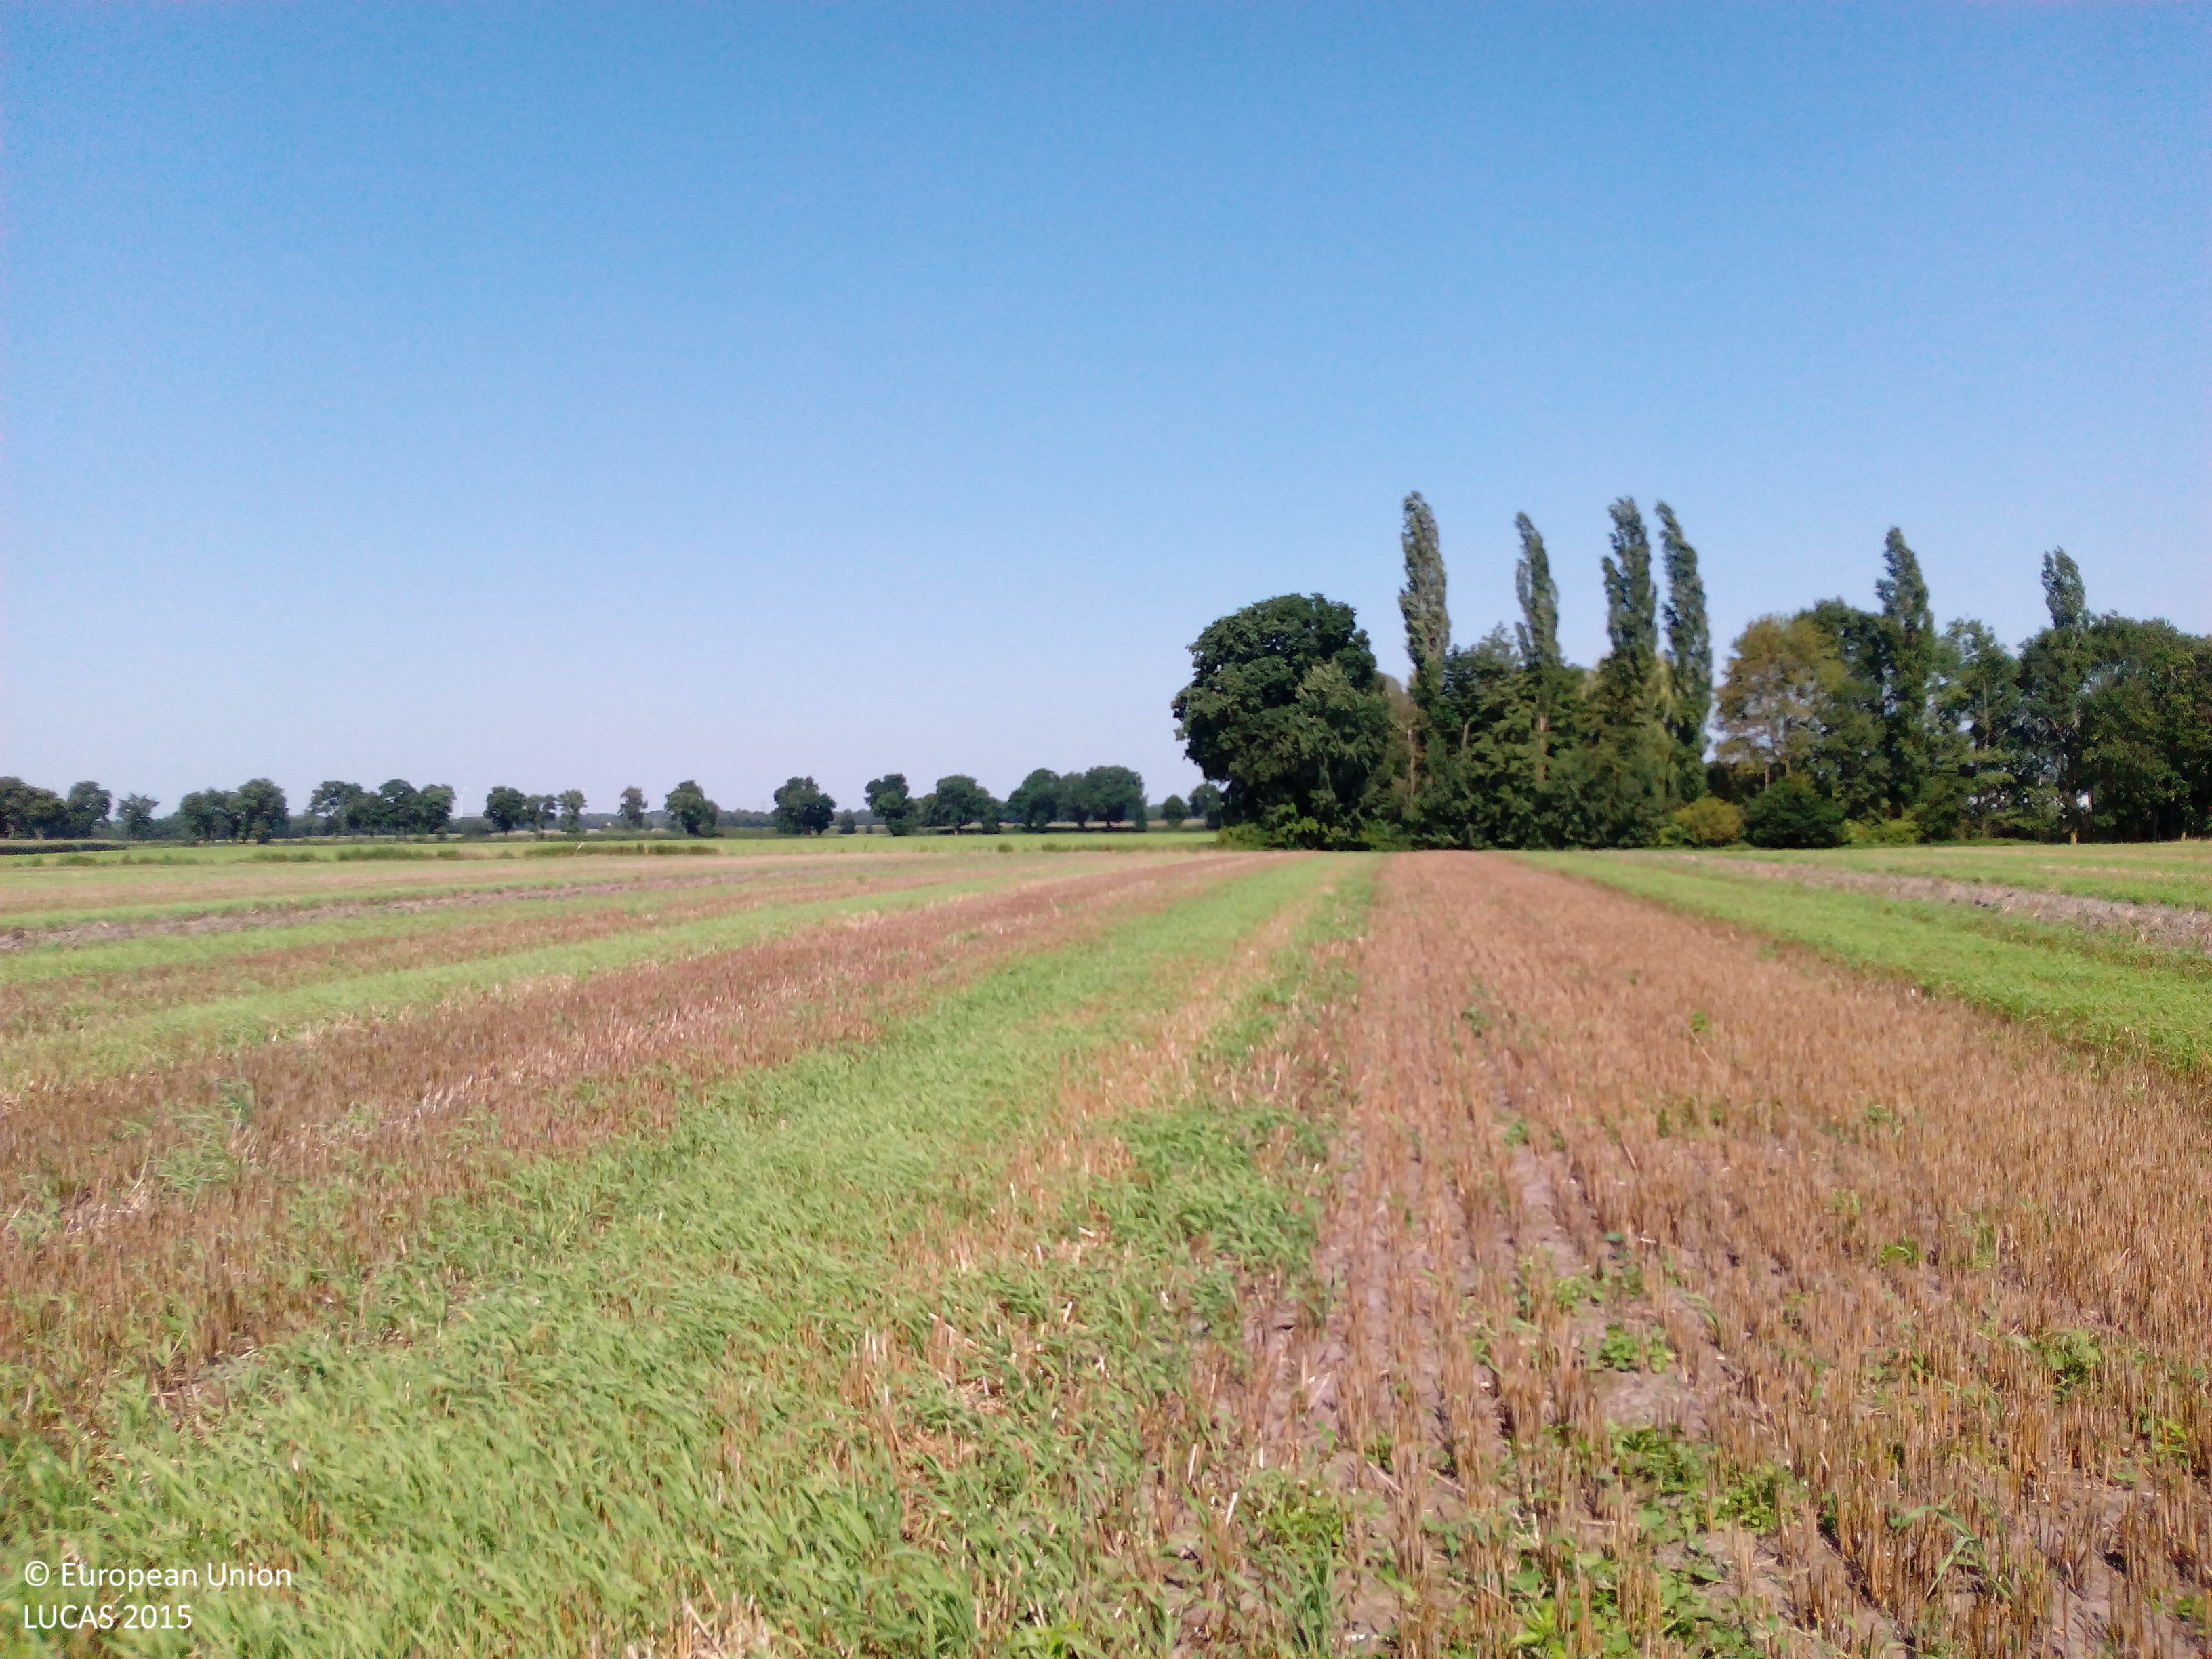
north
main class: Cropland
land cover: Barley
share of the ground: > 75 %
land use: Agriculture (excluding fallow land and kitchen gardens)
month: August
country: DE
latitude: 52.7562
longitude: 8.0002
